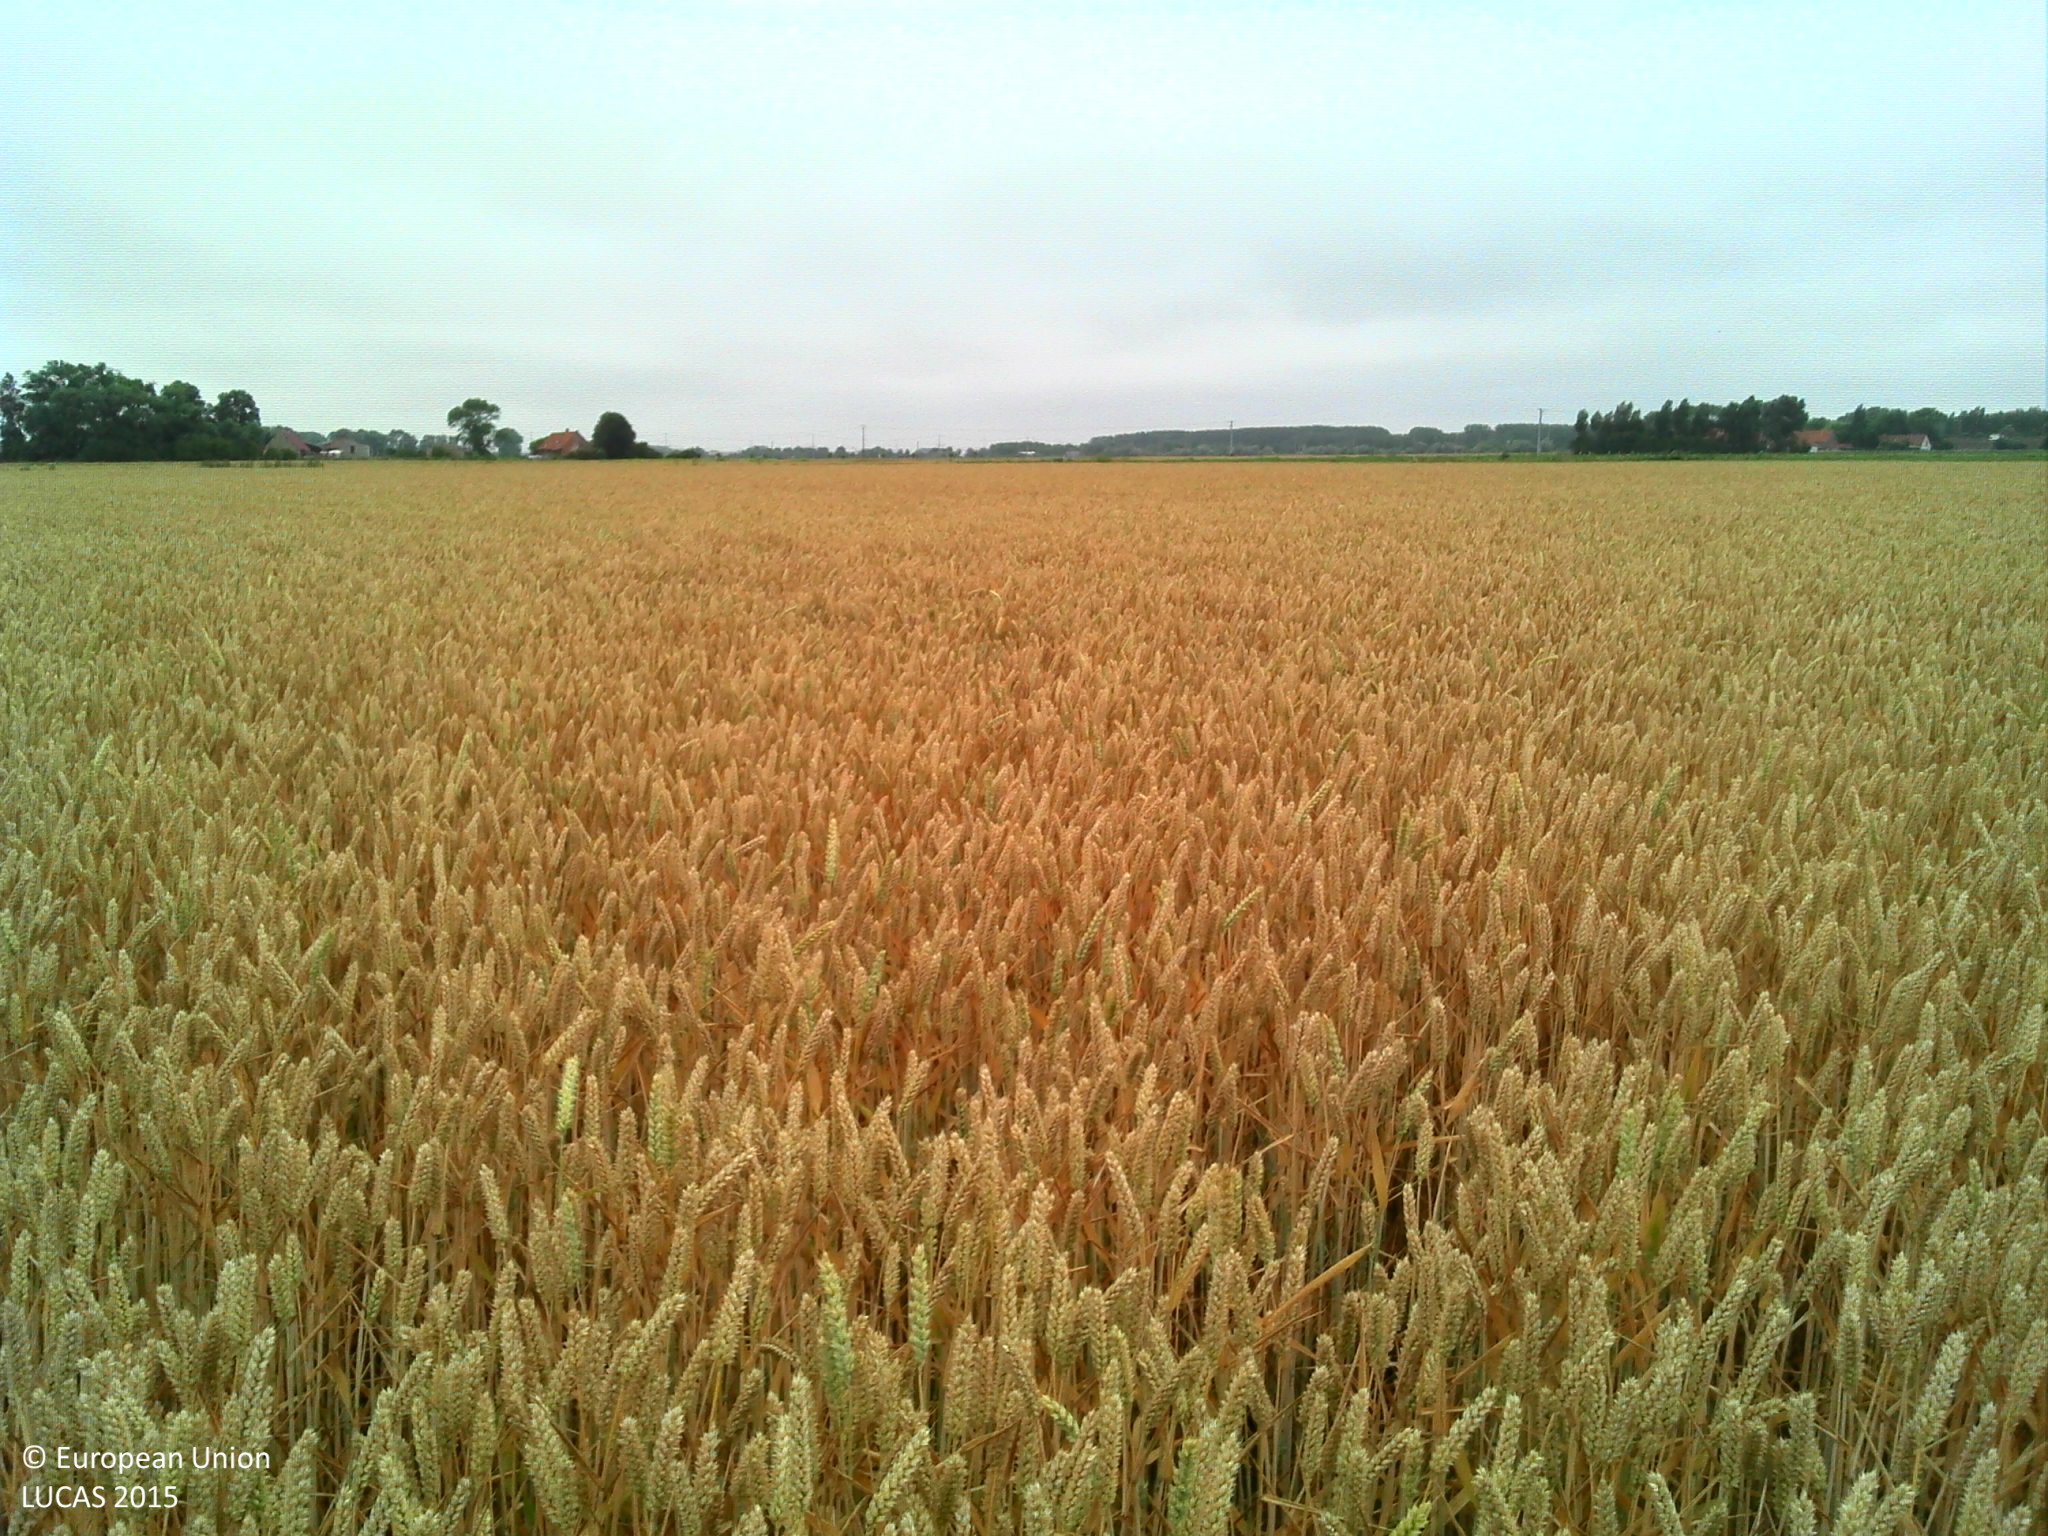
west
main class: Cropland
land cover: Common wheat
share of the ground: > 75 %
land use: Agriculture (excluding fallow land and kitchen gardens)
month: July
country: FR
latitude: 50.9861
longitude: 2.2504
